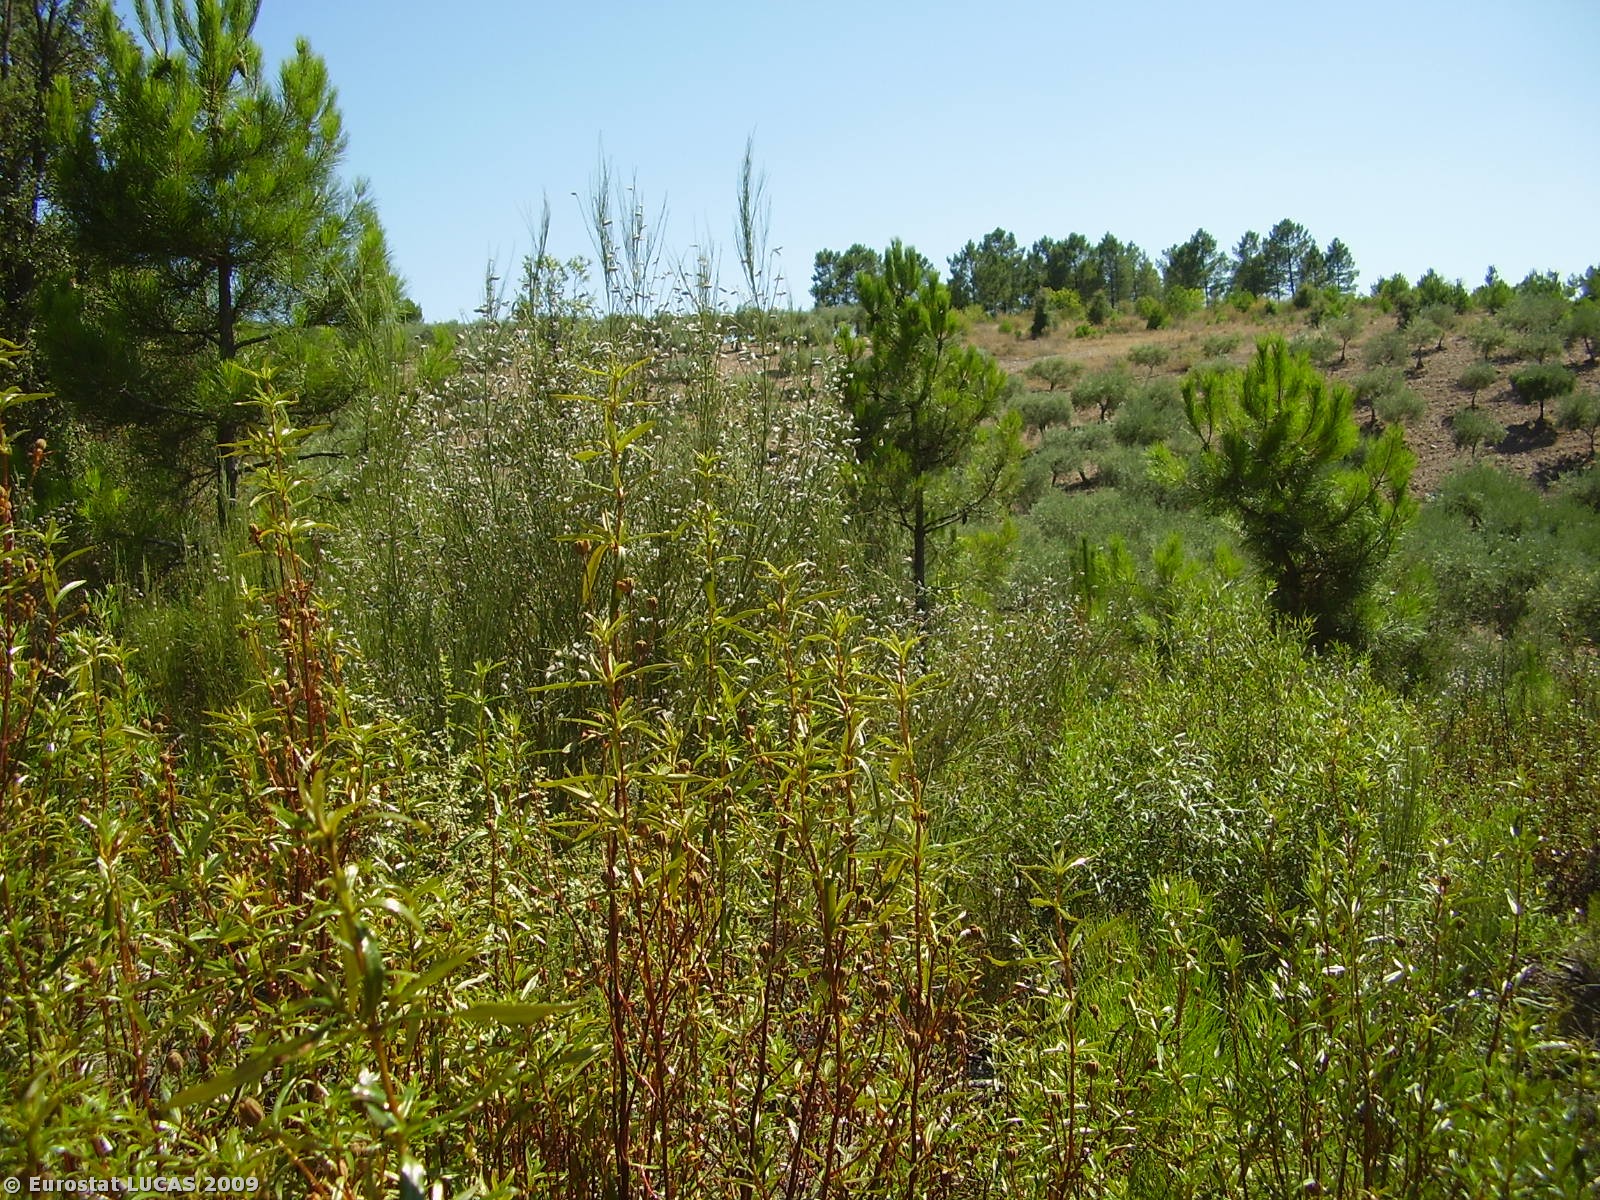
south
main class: Shrubland
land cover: Shrubland with sparse tree cover
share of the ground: > 75 %
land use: Fallow land
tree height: > 5 m
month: August
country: PT
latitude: 41.2217
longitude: -6.7934
